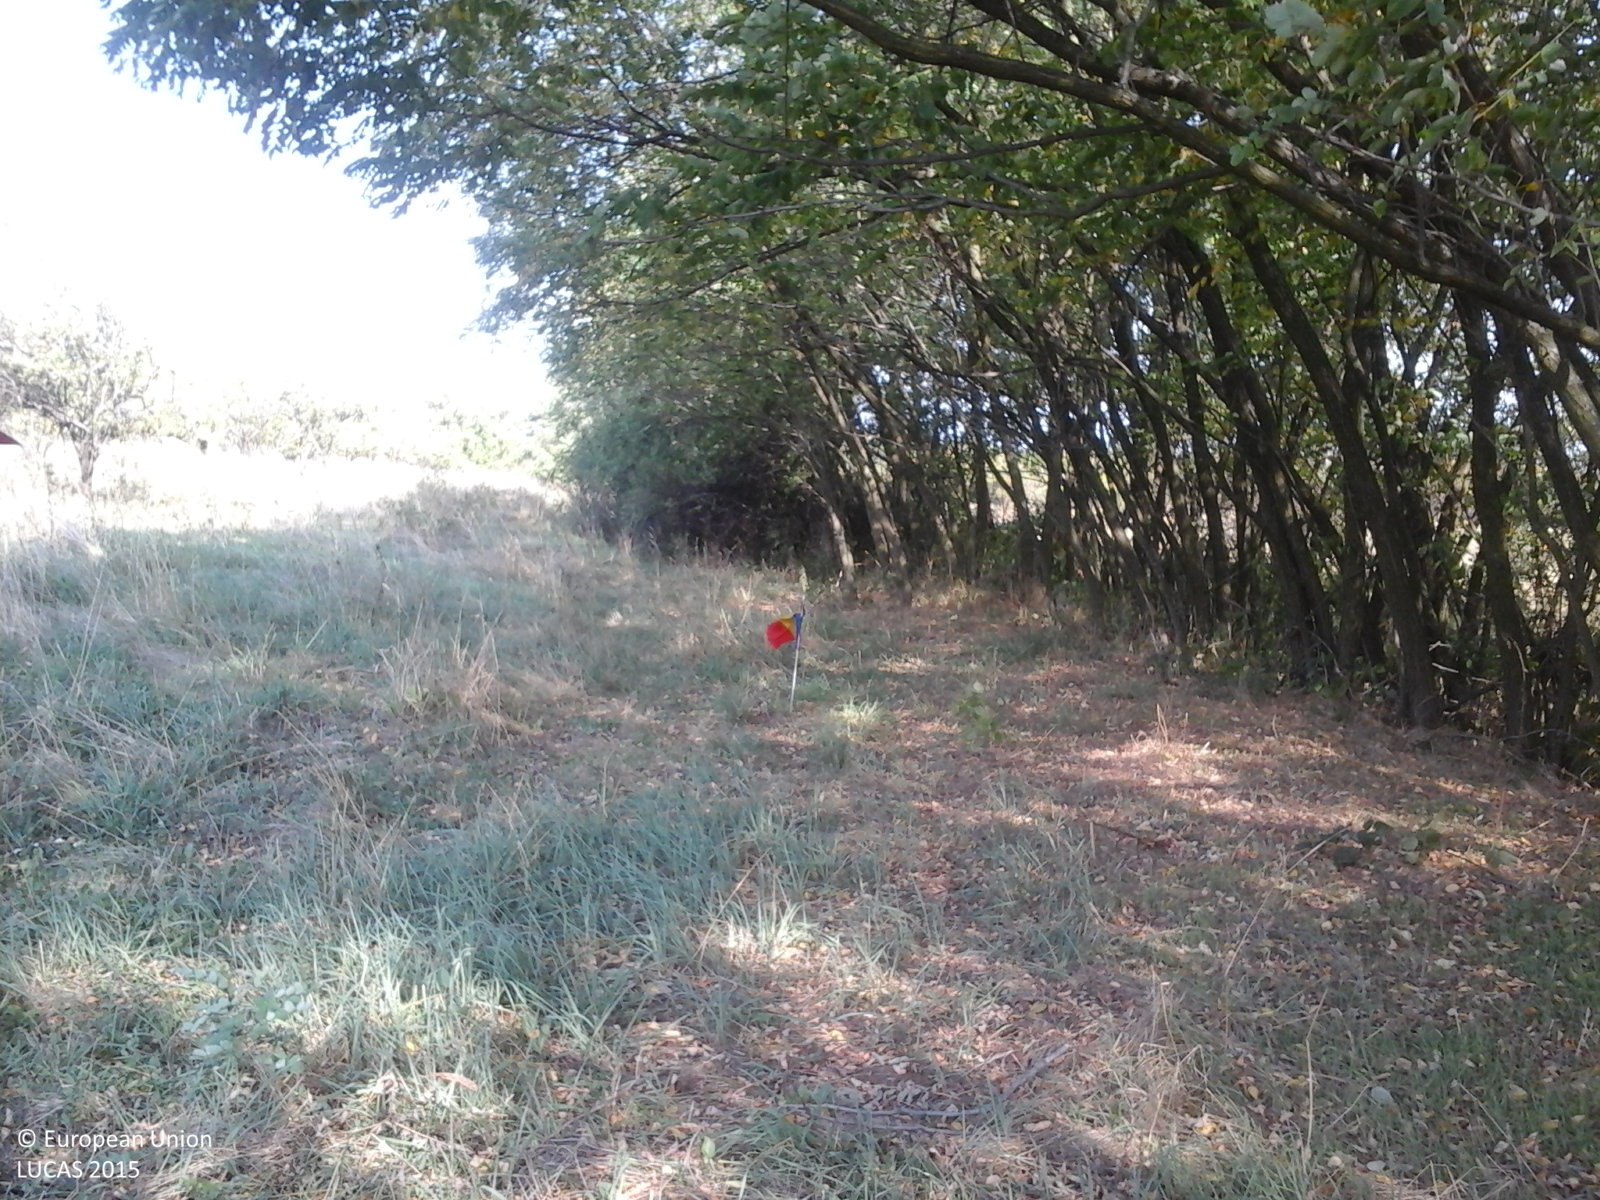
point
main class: Grassland
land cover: Grassland with sparse tree/shrub cover
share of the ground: > 75 %
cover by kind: herbaceous plants 85 %, shrubs 10 %, broadleaved forest trees 5 %
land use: Agriculture (excluding fallow land and kitchen gardens)
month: September
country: RO
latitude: 45.0739
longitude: 22.2973
